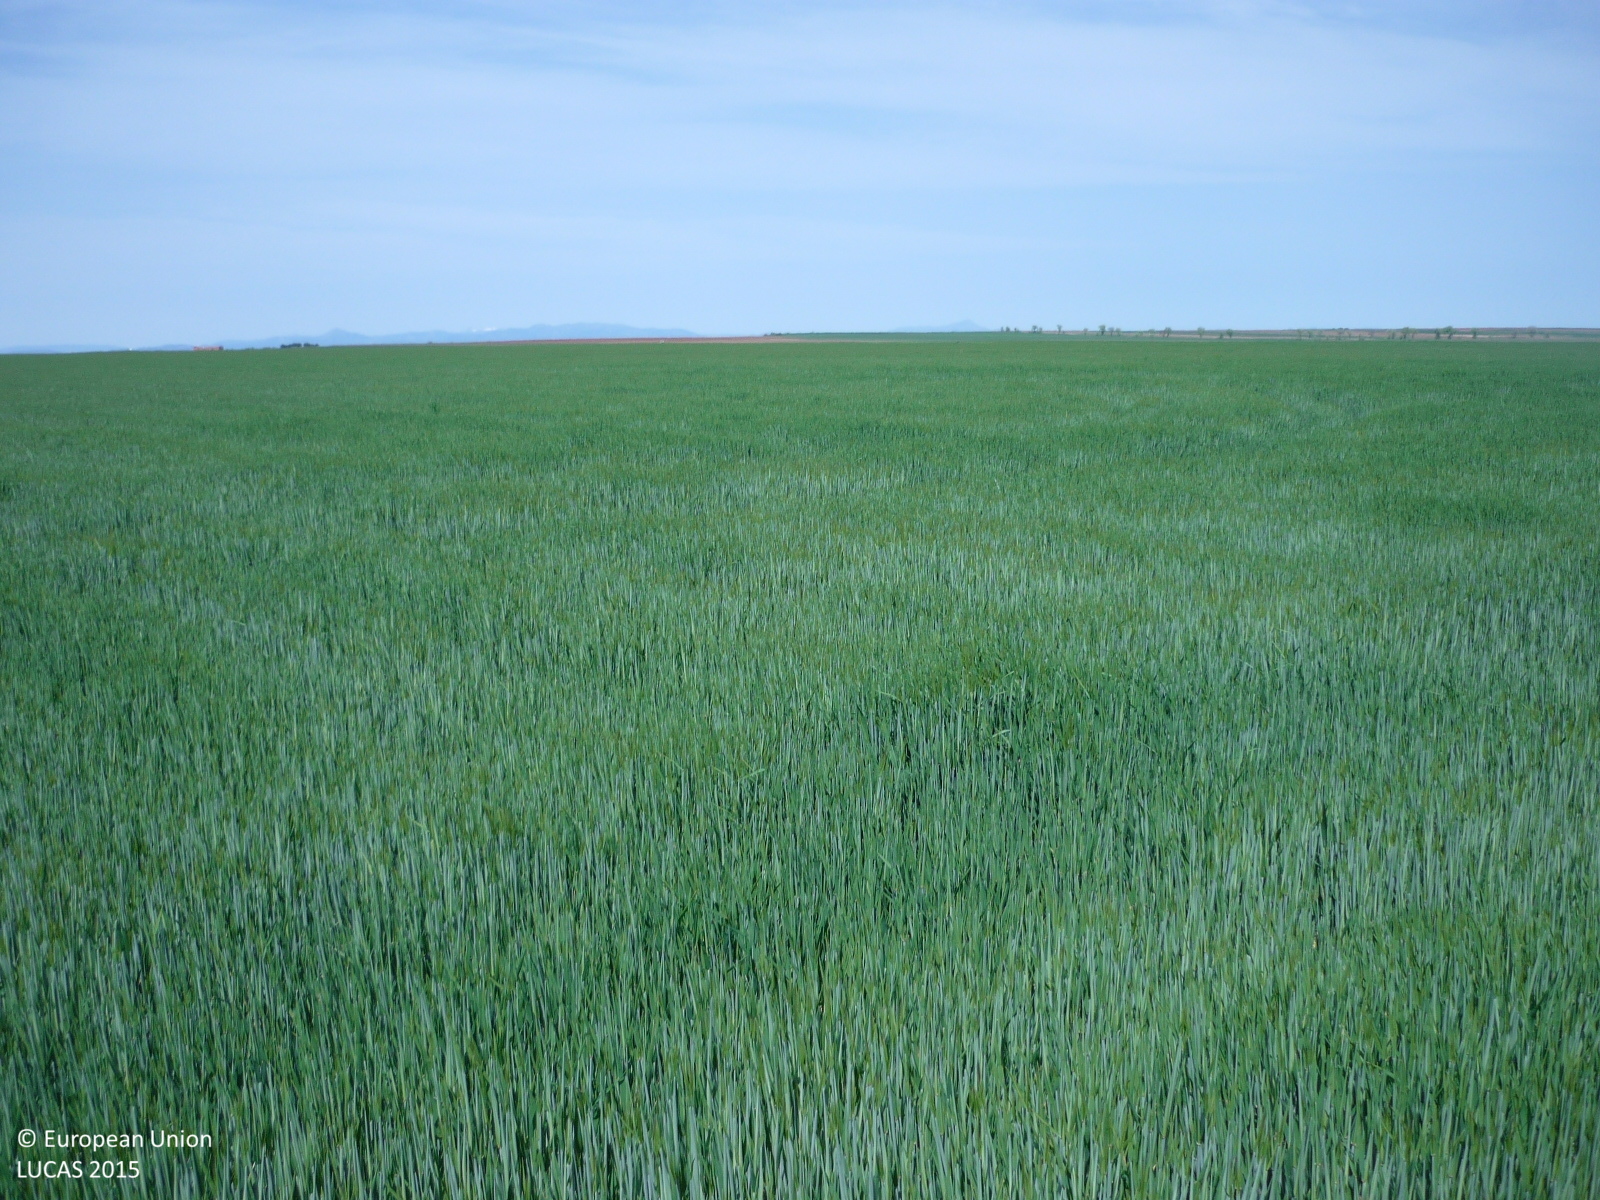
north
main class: Cropland
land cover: Common wheat
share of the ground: > 75 %
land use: Agriculture (excluding fallow land and kitchen gardens)
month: April
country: ES
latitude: 40.5982
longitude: -3.3291
